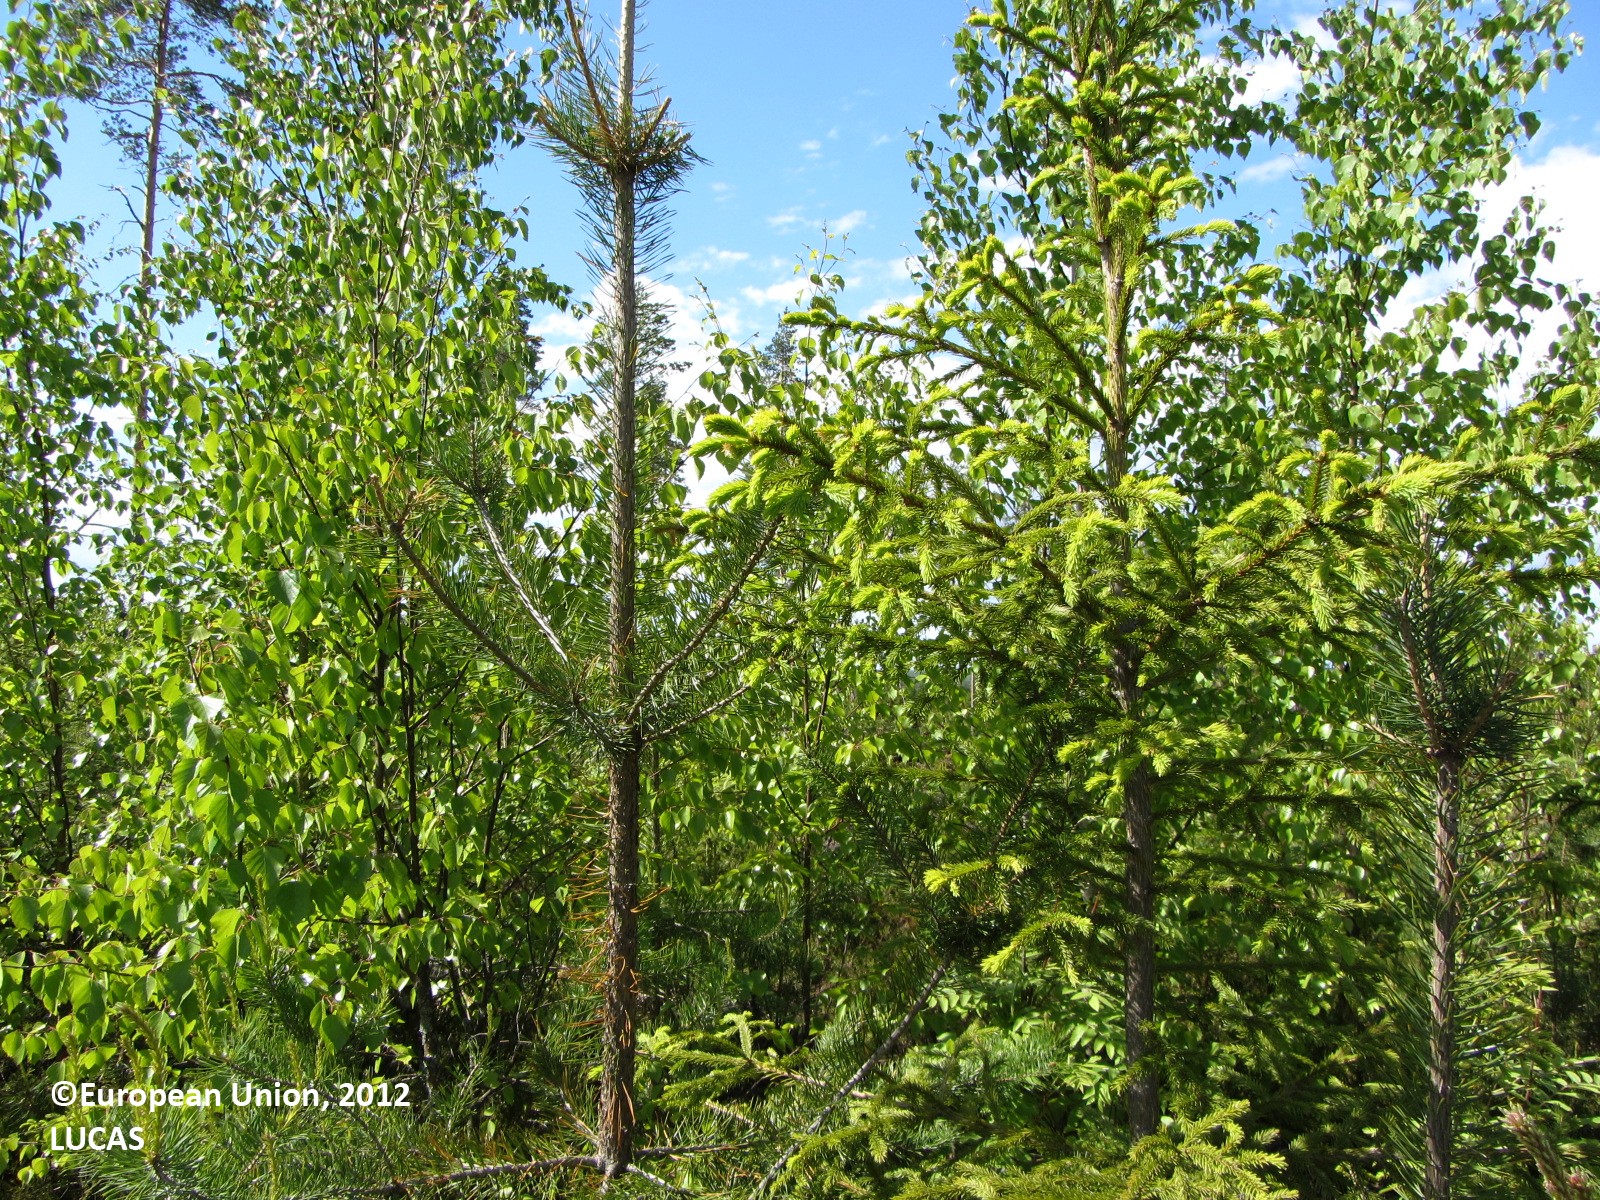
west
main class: Woodland
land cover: Other mixed woodland
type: hemiboreal forest and nemoral coniferous forest and mixed broadleaved-coniferous forest
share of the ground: > 75 %
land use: Forestry
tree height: < 5 m
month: June
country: FI
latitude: 61.7318
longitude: 25.1197
